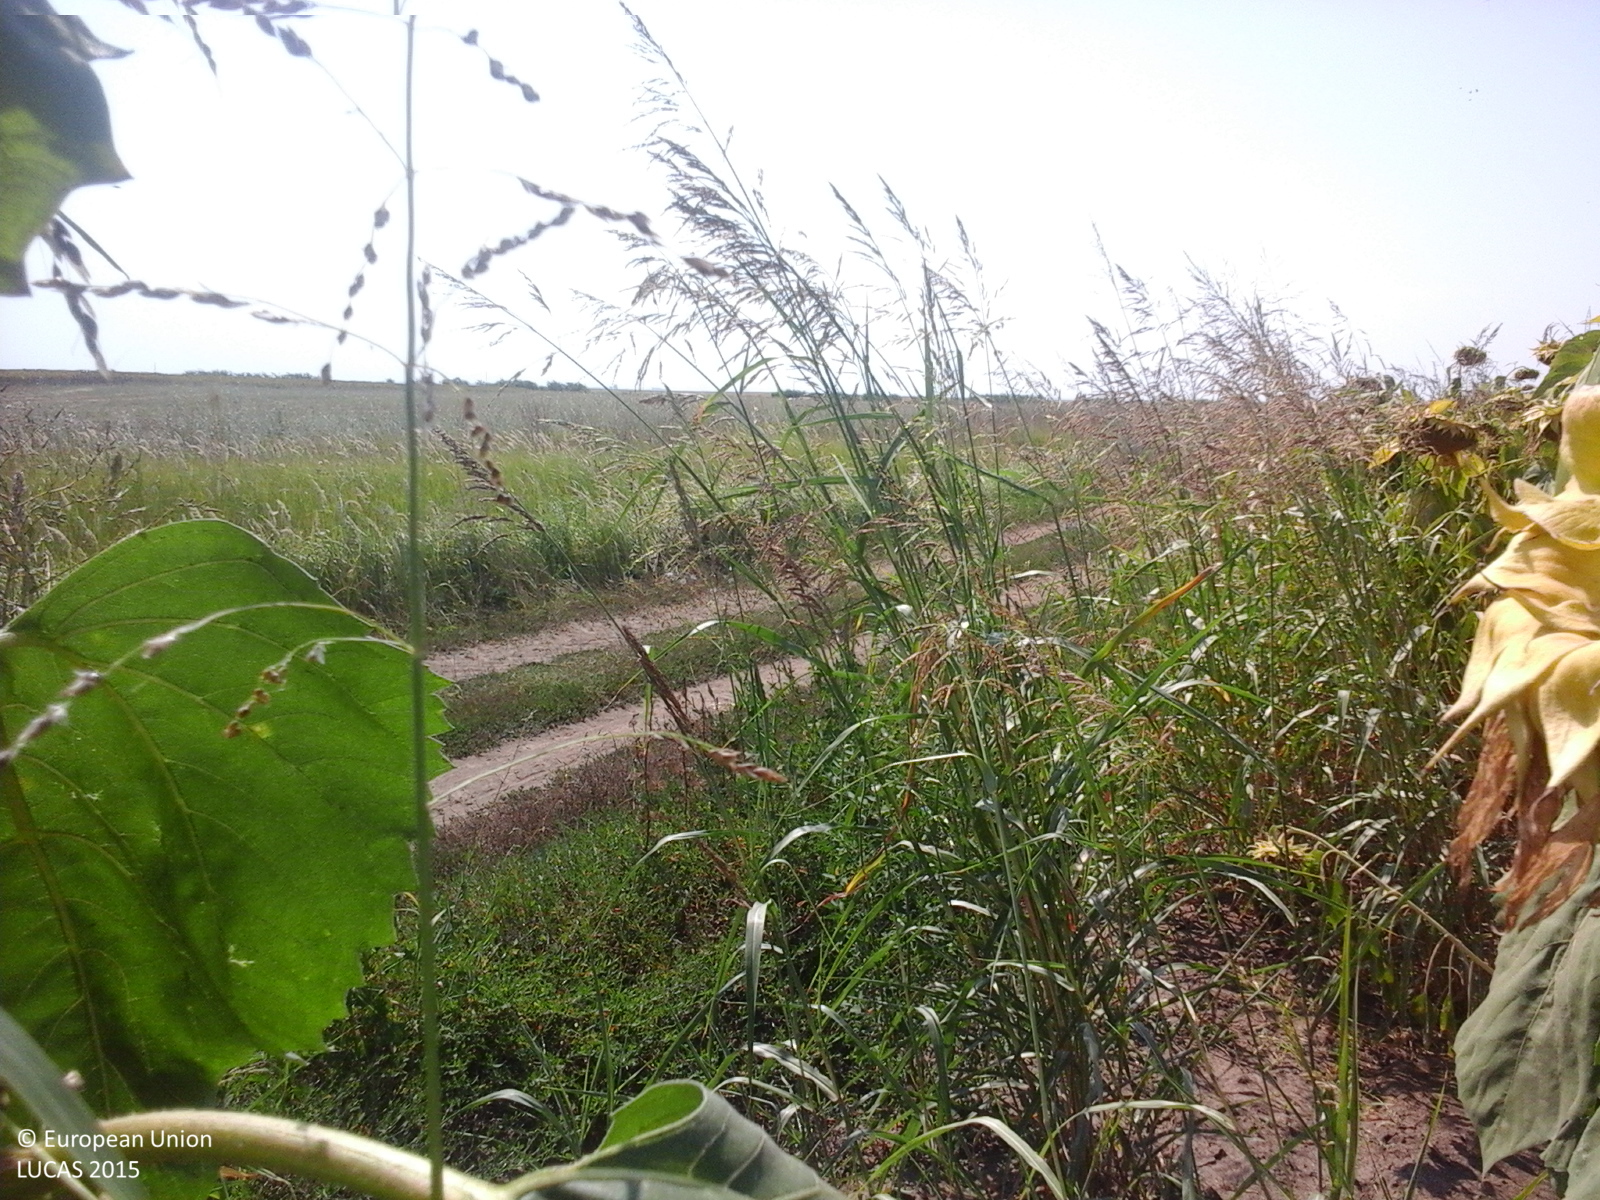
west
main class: Cropland
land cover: Sunflower
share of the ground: > 75 %
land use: Agriculture (excluding fallow land and kitchen gardens)
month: August
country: RO
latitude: 45.2555
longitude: 27.7563
